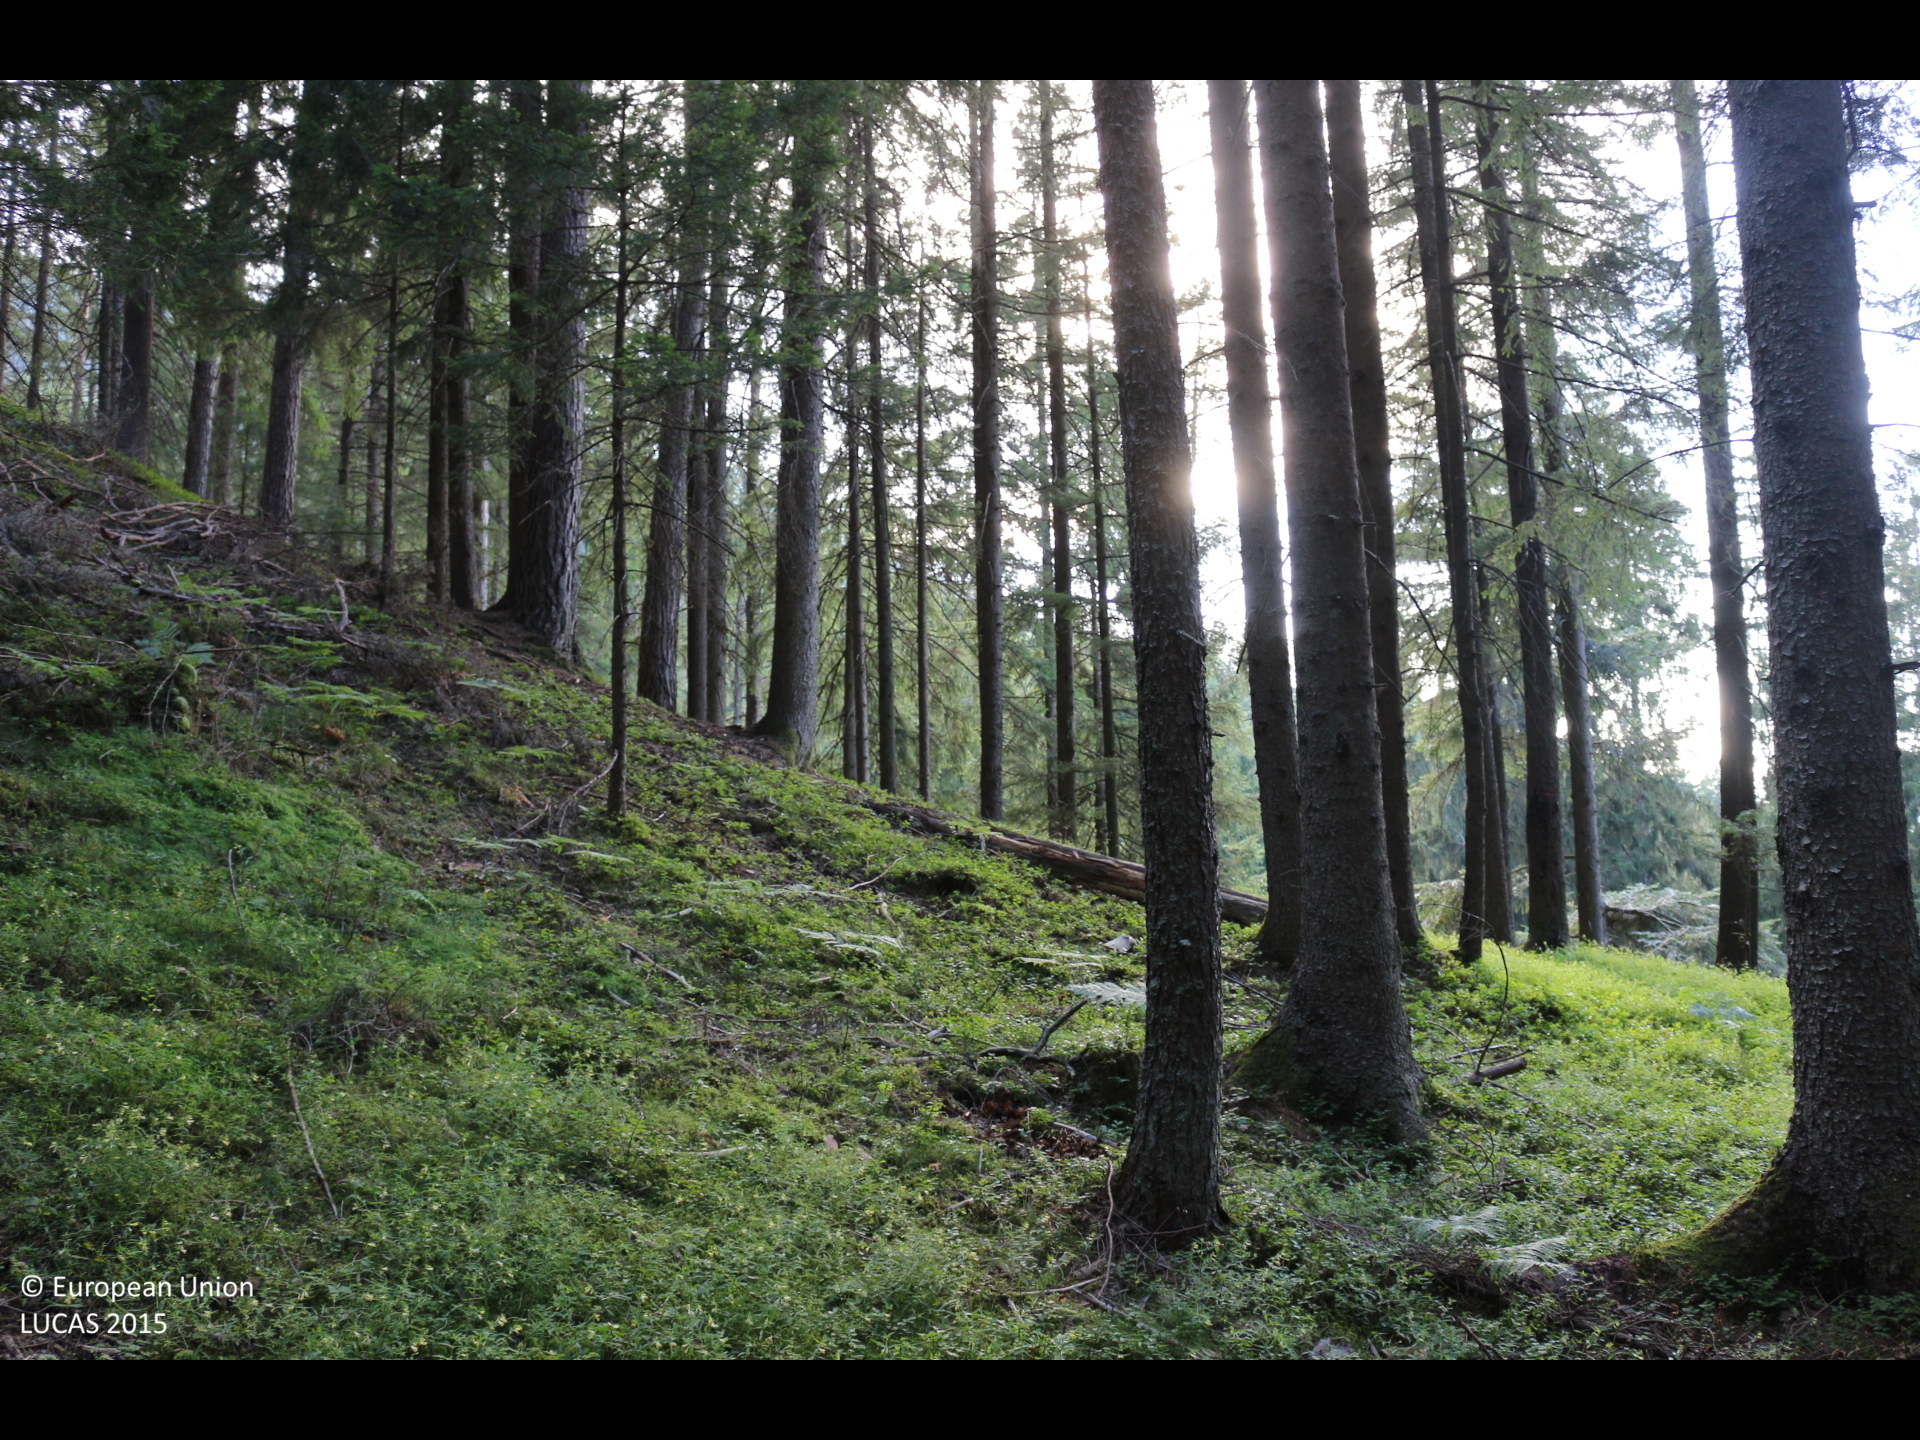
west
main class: Woodland
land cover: Other coniferous woodland
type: alpine coniferous forest
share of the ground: > 75 %
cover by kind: coniferous forest trees 100 %
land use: Forestry
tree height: > 5 m
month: July
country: AT
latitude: 46.8005
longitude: 13.4434
